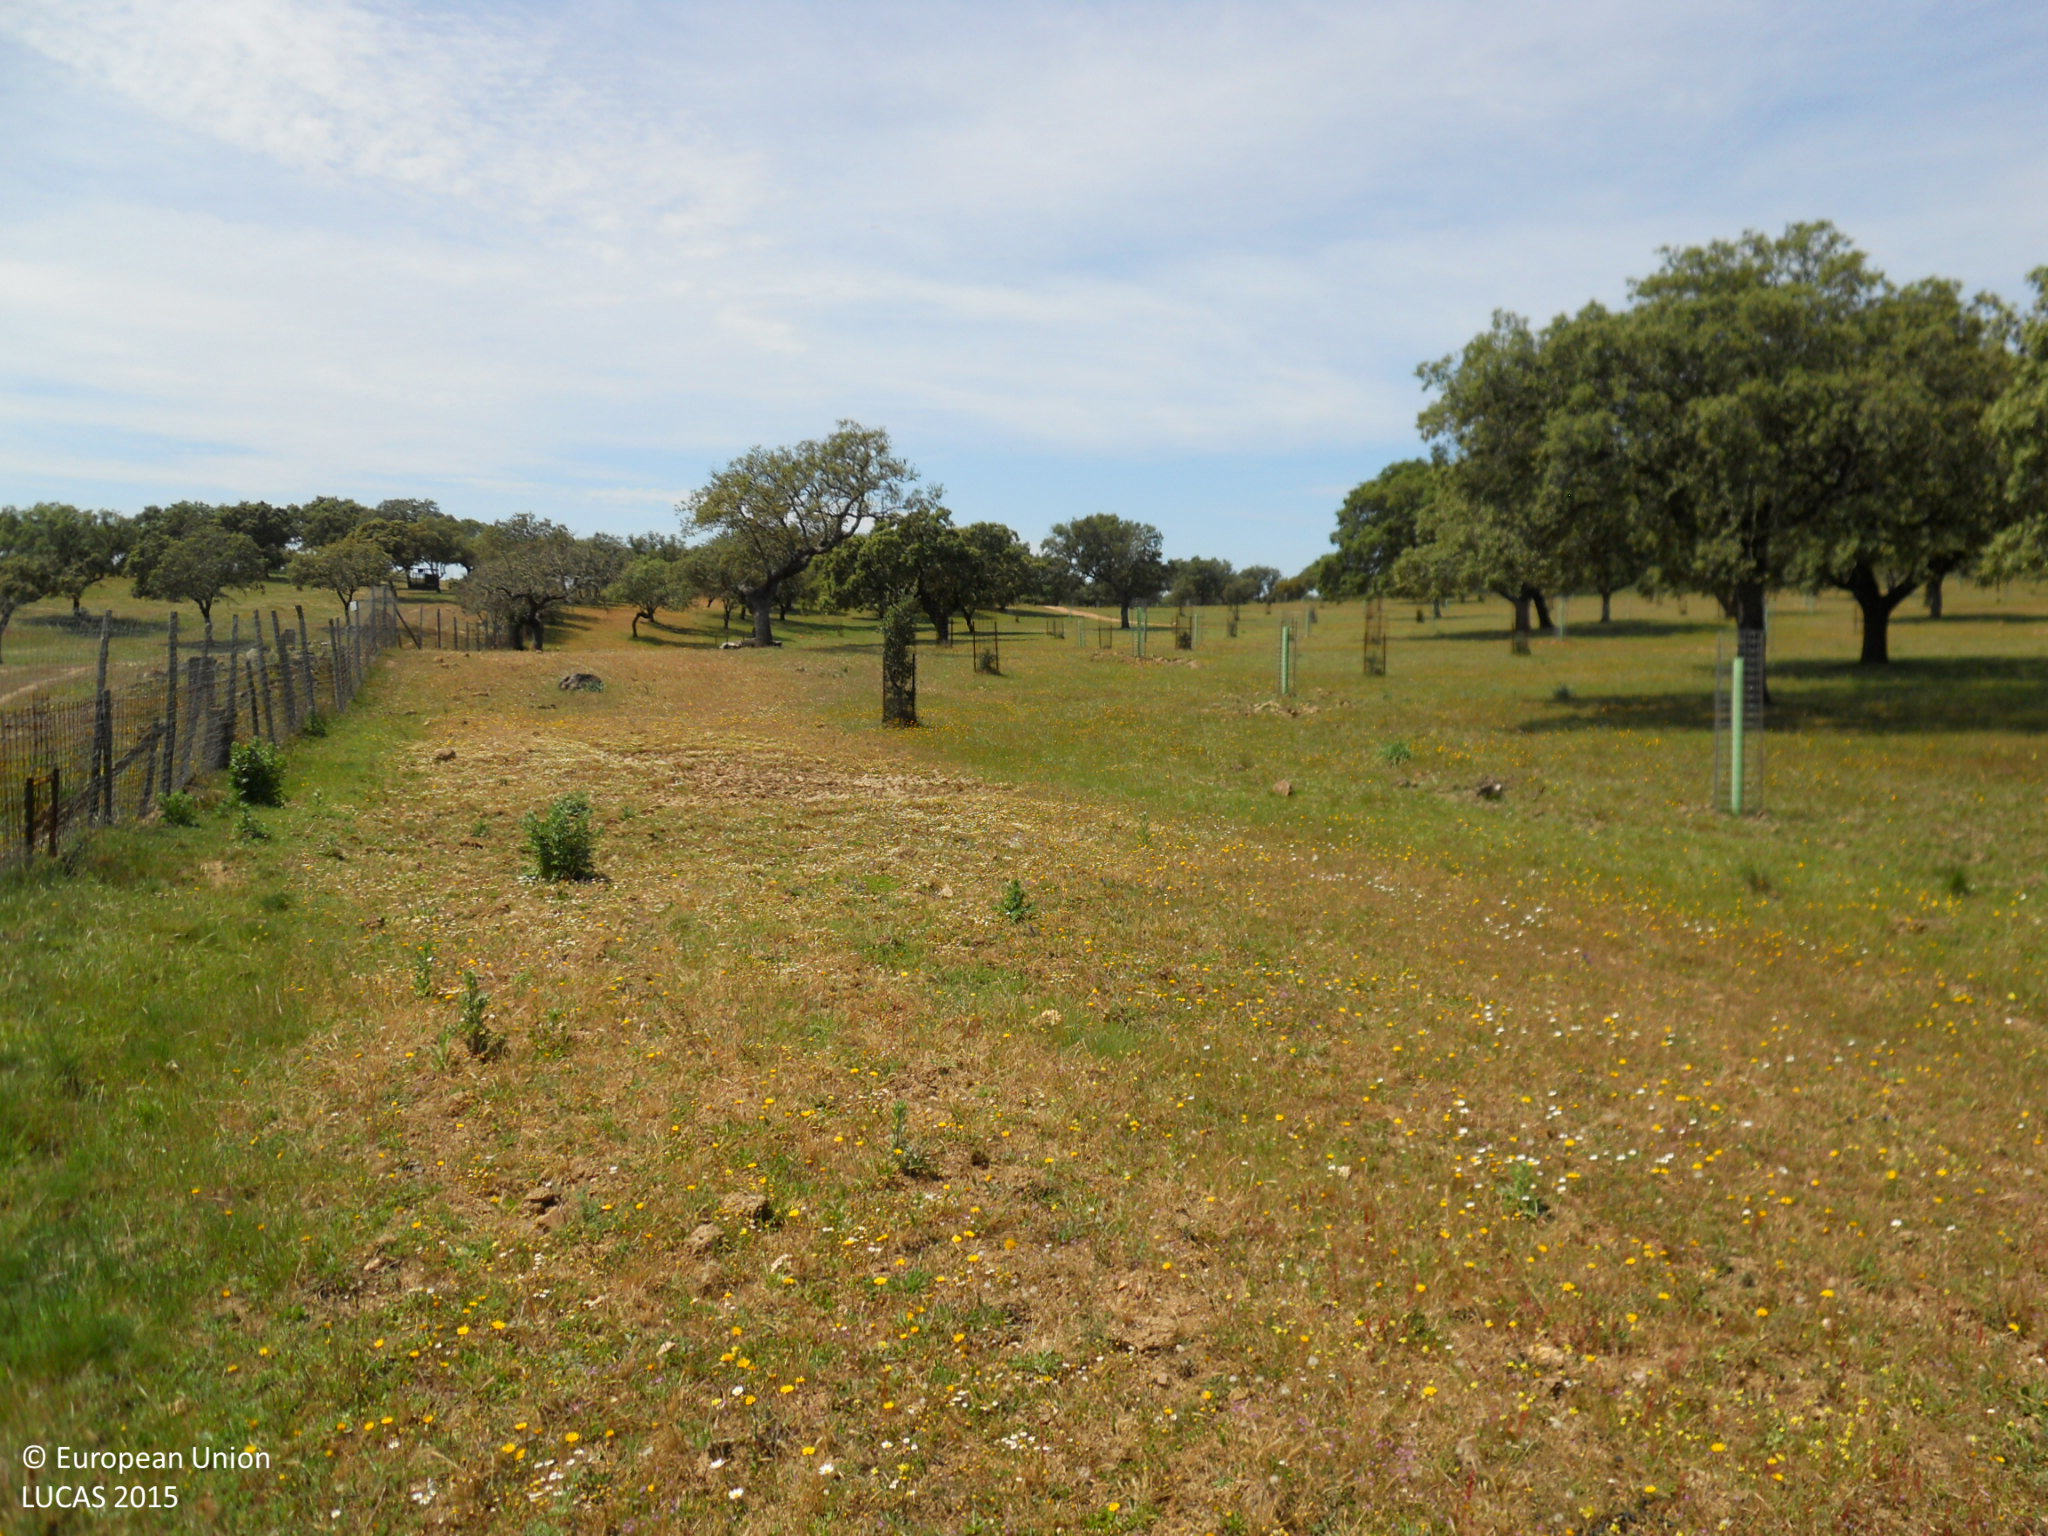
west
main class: Grassland
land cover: Grassland with sparse tree/shrub cover
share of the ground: > 75 %
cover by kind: herbaceous plants 90 %, broadleaved forest trees 5 %, shrubs 5 %
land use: Agriculture (excluding fallow land and kitchen gardens)
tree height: < 5 m
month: April
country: ES
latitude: 39.1680
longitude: -6.8433
